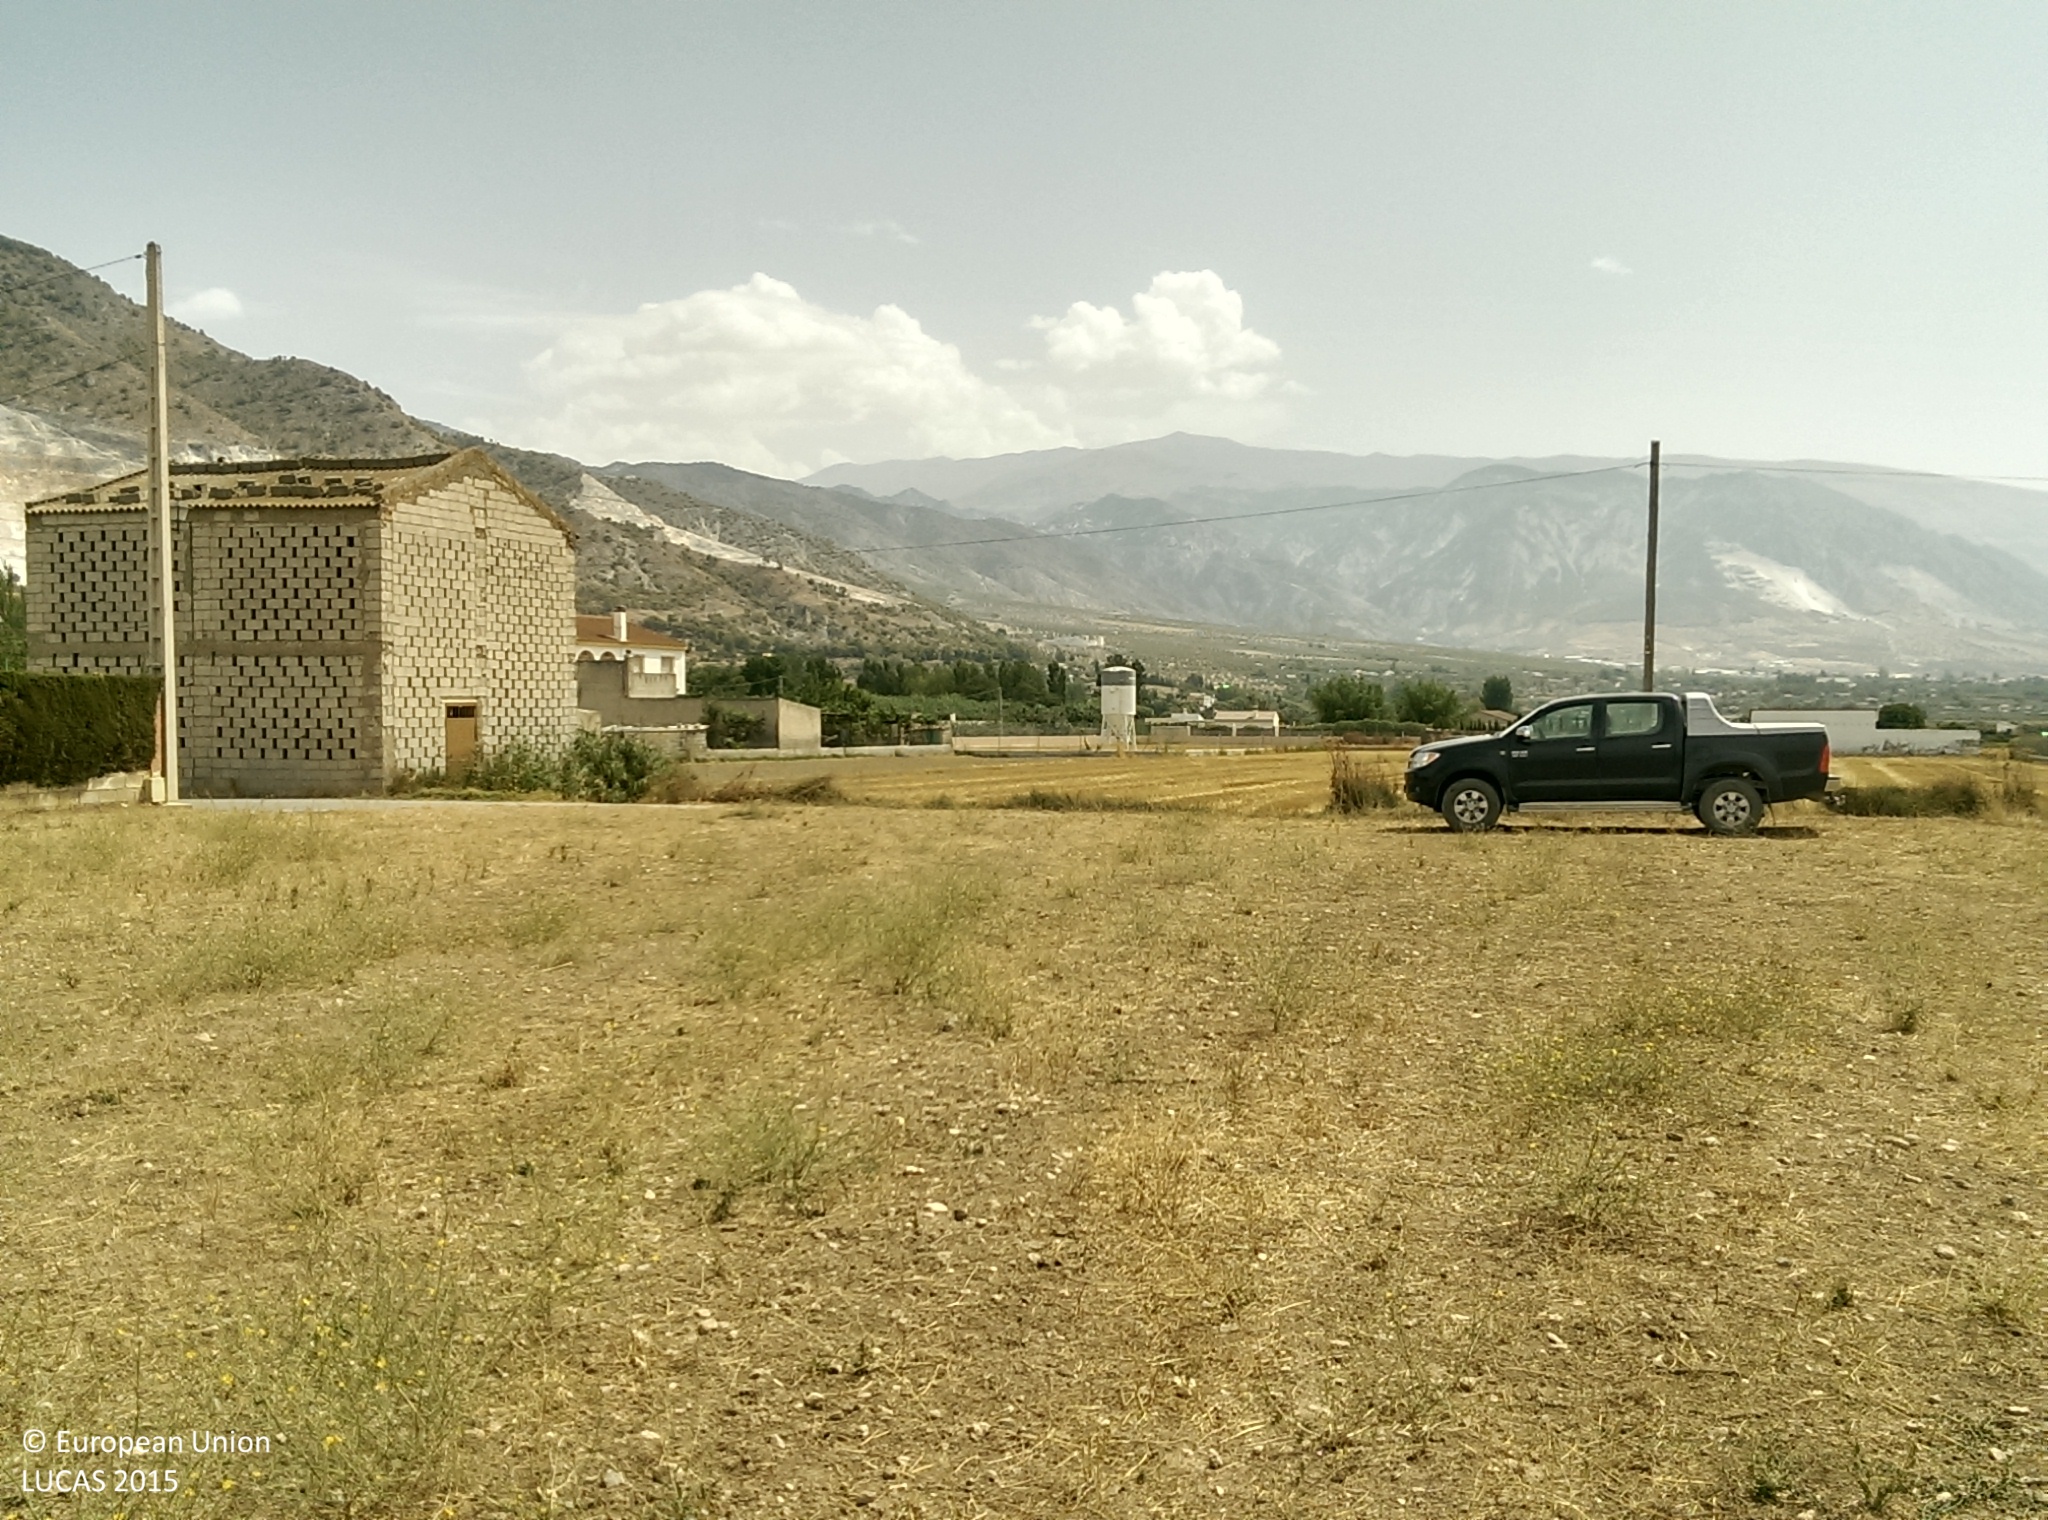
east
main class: Grassland
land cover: Spontaneously vegetated surfaces
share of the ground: 25 - 50 %
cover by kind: unconsolidated bare surface 70 %, herbaceous plants 30 %
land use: Agriculture (excluding fallow land and kitchen gardens)
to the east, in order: Spontaneously vegetated surfaces; Tracks; Grass margins; Ditches and canals; Barley; Grass margins; Other bare soil; Fences; Barley; Fences; Grass margins; Tracks; Electric lines; Fences; Artificial constructions in urban areas
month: August
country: ES
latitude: 37.0196
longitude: -3.6209
